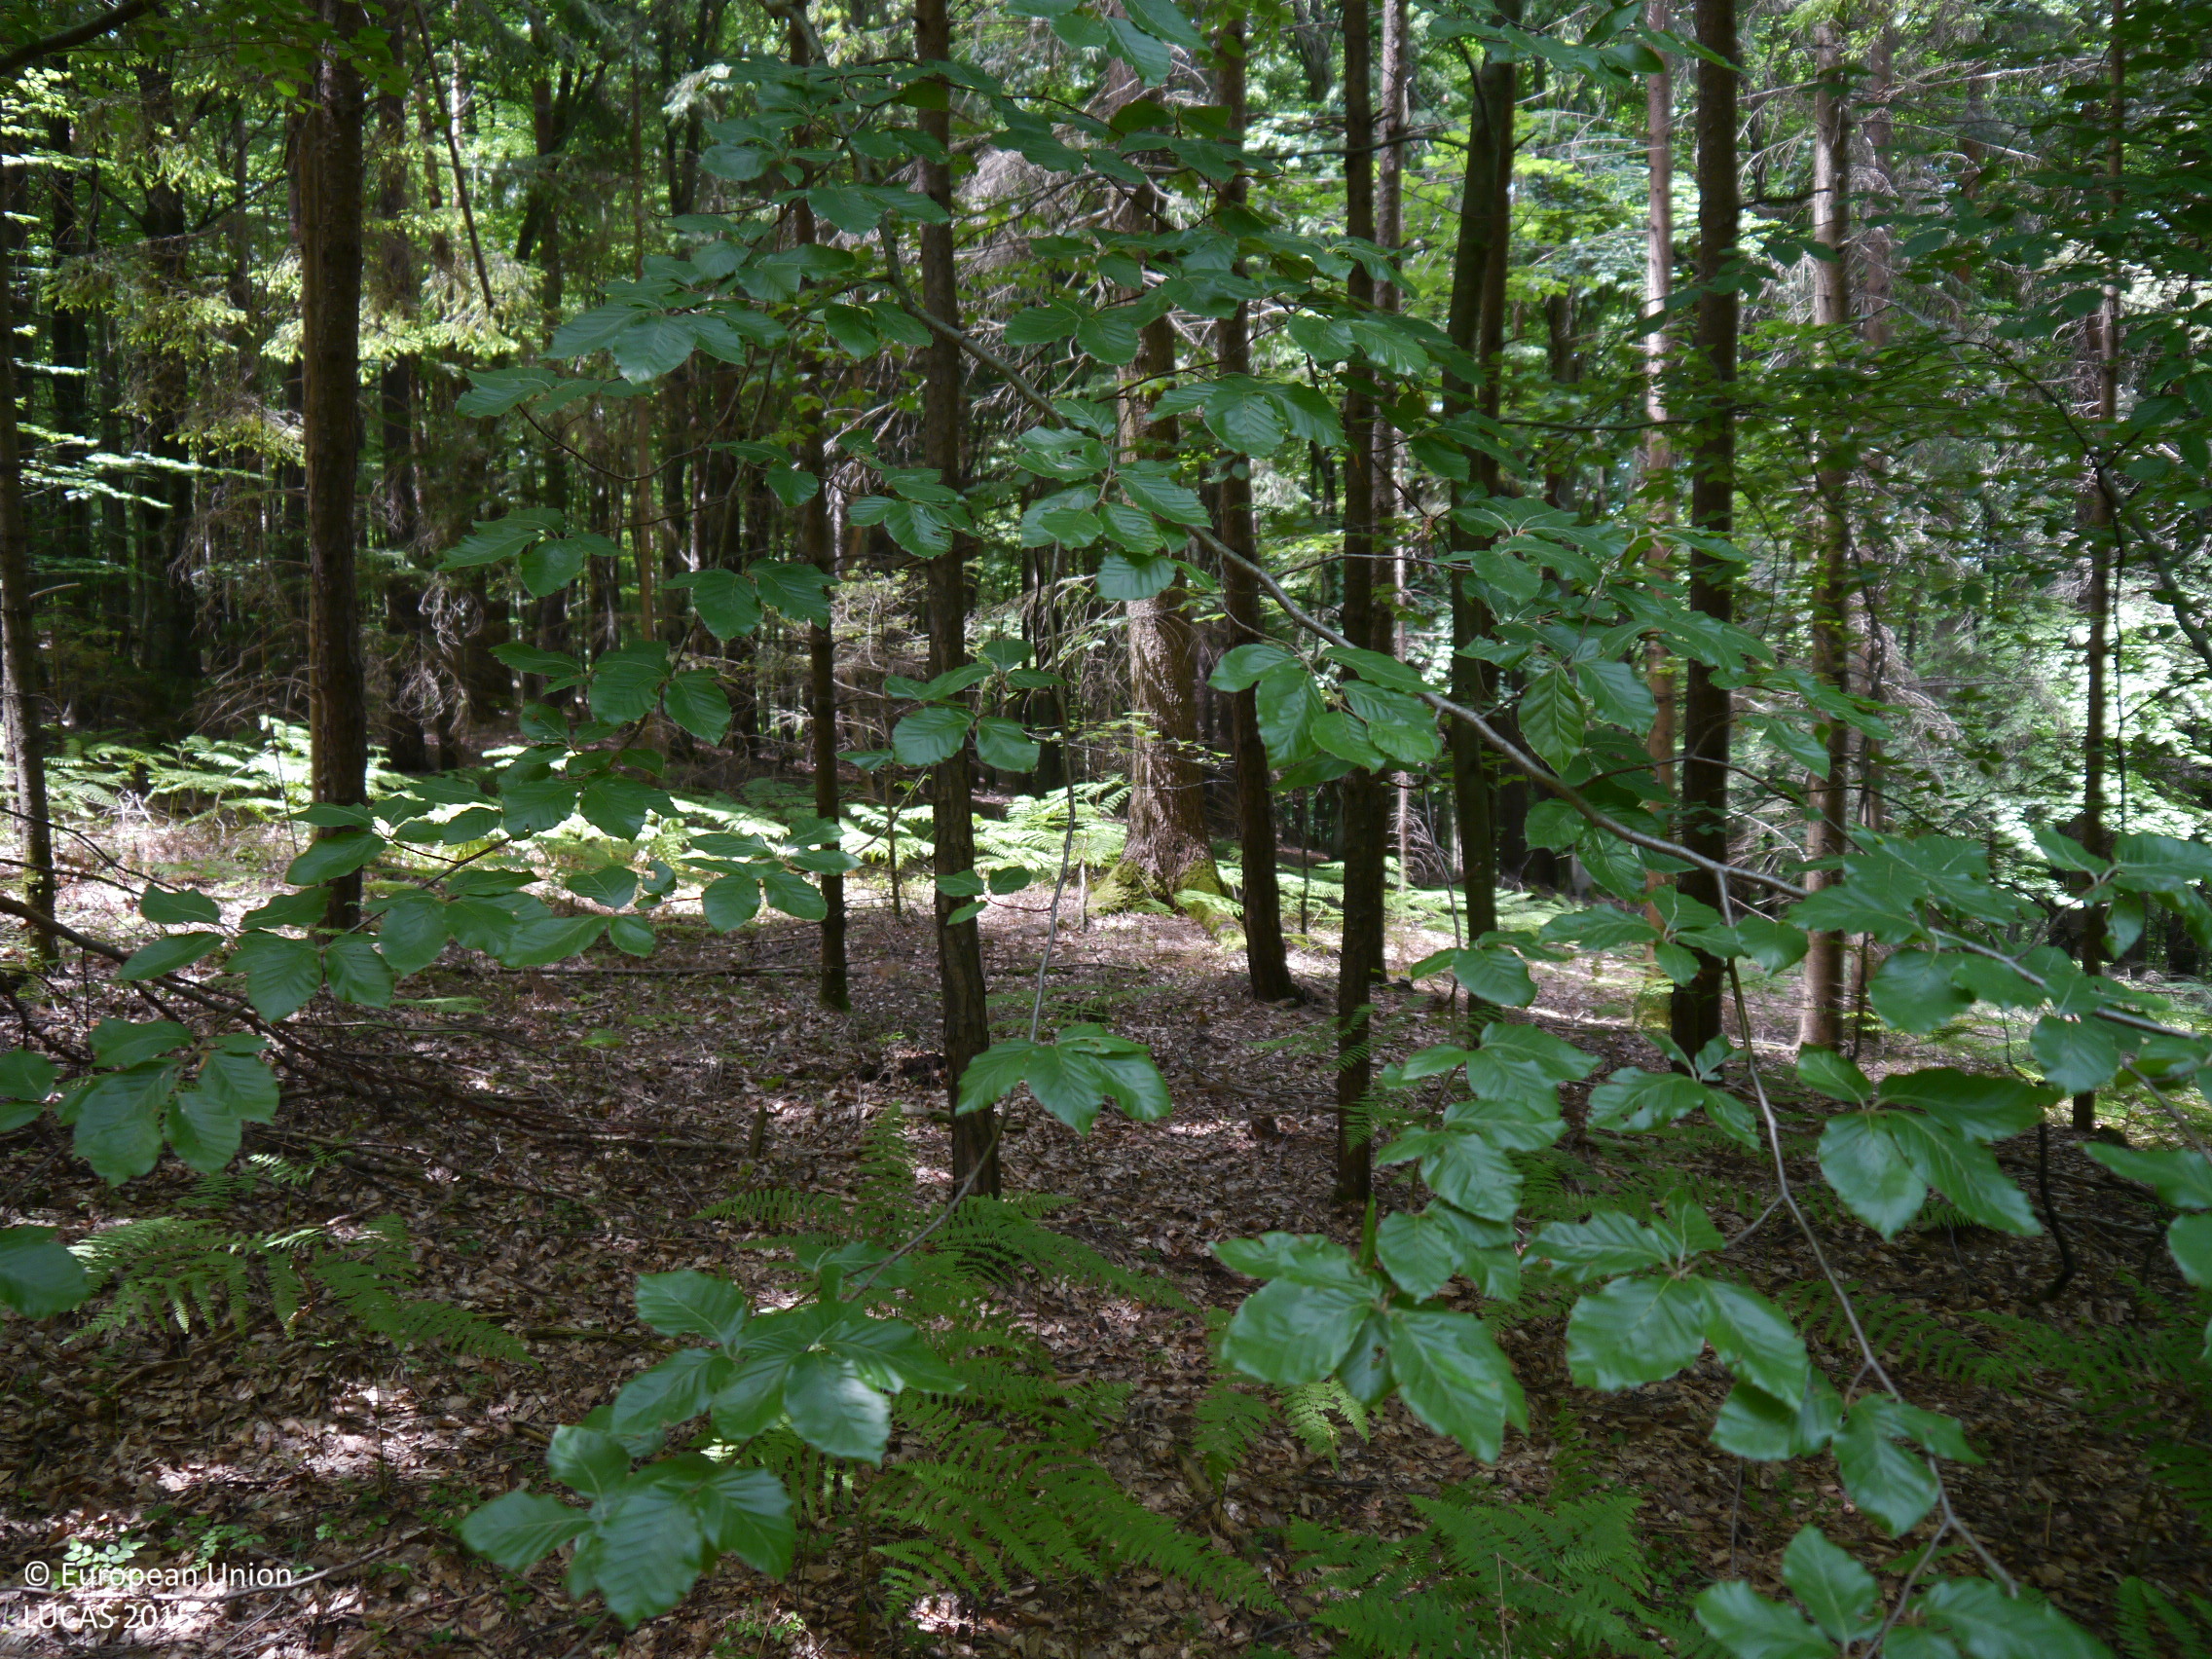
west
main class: Woodland
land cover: Pine dominated mixed woodland
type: hemiboreal forest and nemoral coniferous forest and mixed broadleaved-coniferous forest
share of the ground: > 75 %
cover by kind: broadleaved forest trees 50 %, coniferous forest trees 45 %, herbaceous plants 5 %
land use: Forestry
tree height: > 5 m
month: June
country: AT
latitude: 46.8668
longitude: 15.7066
